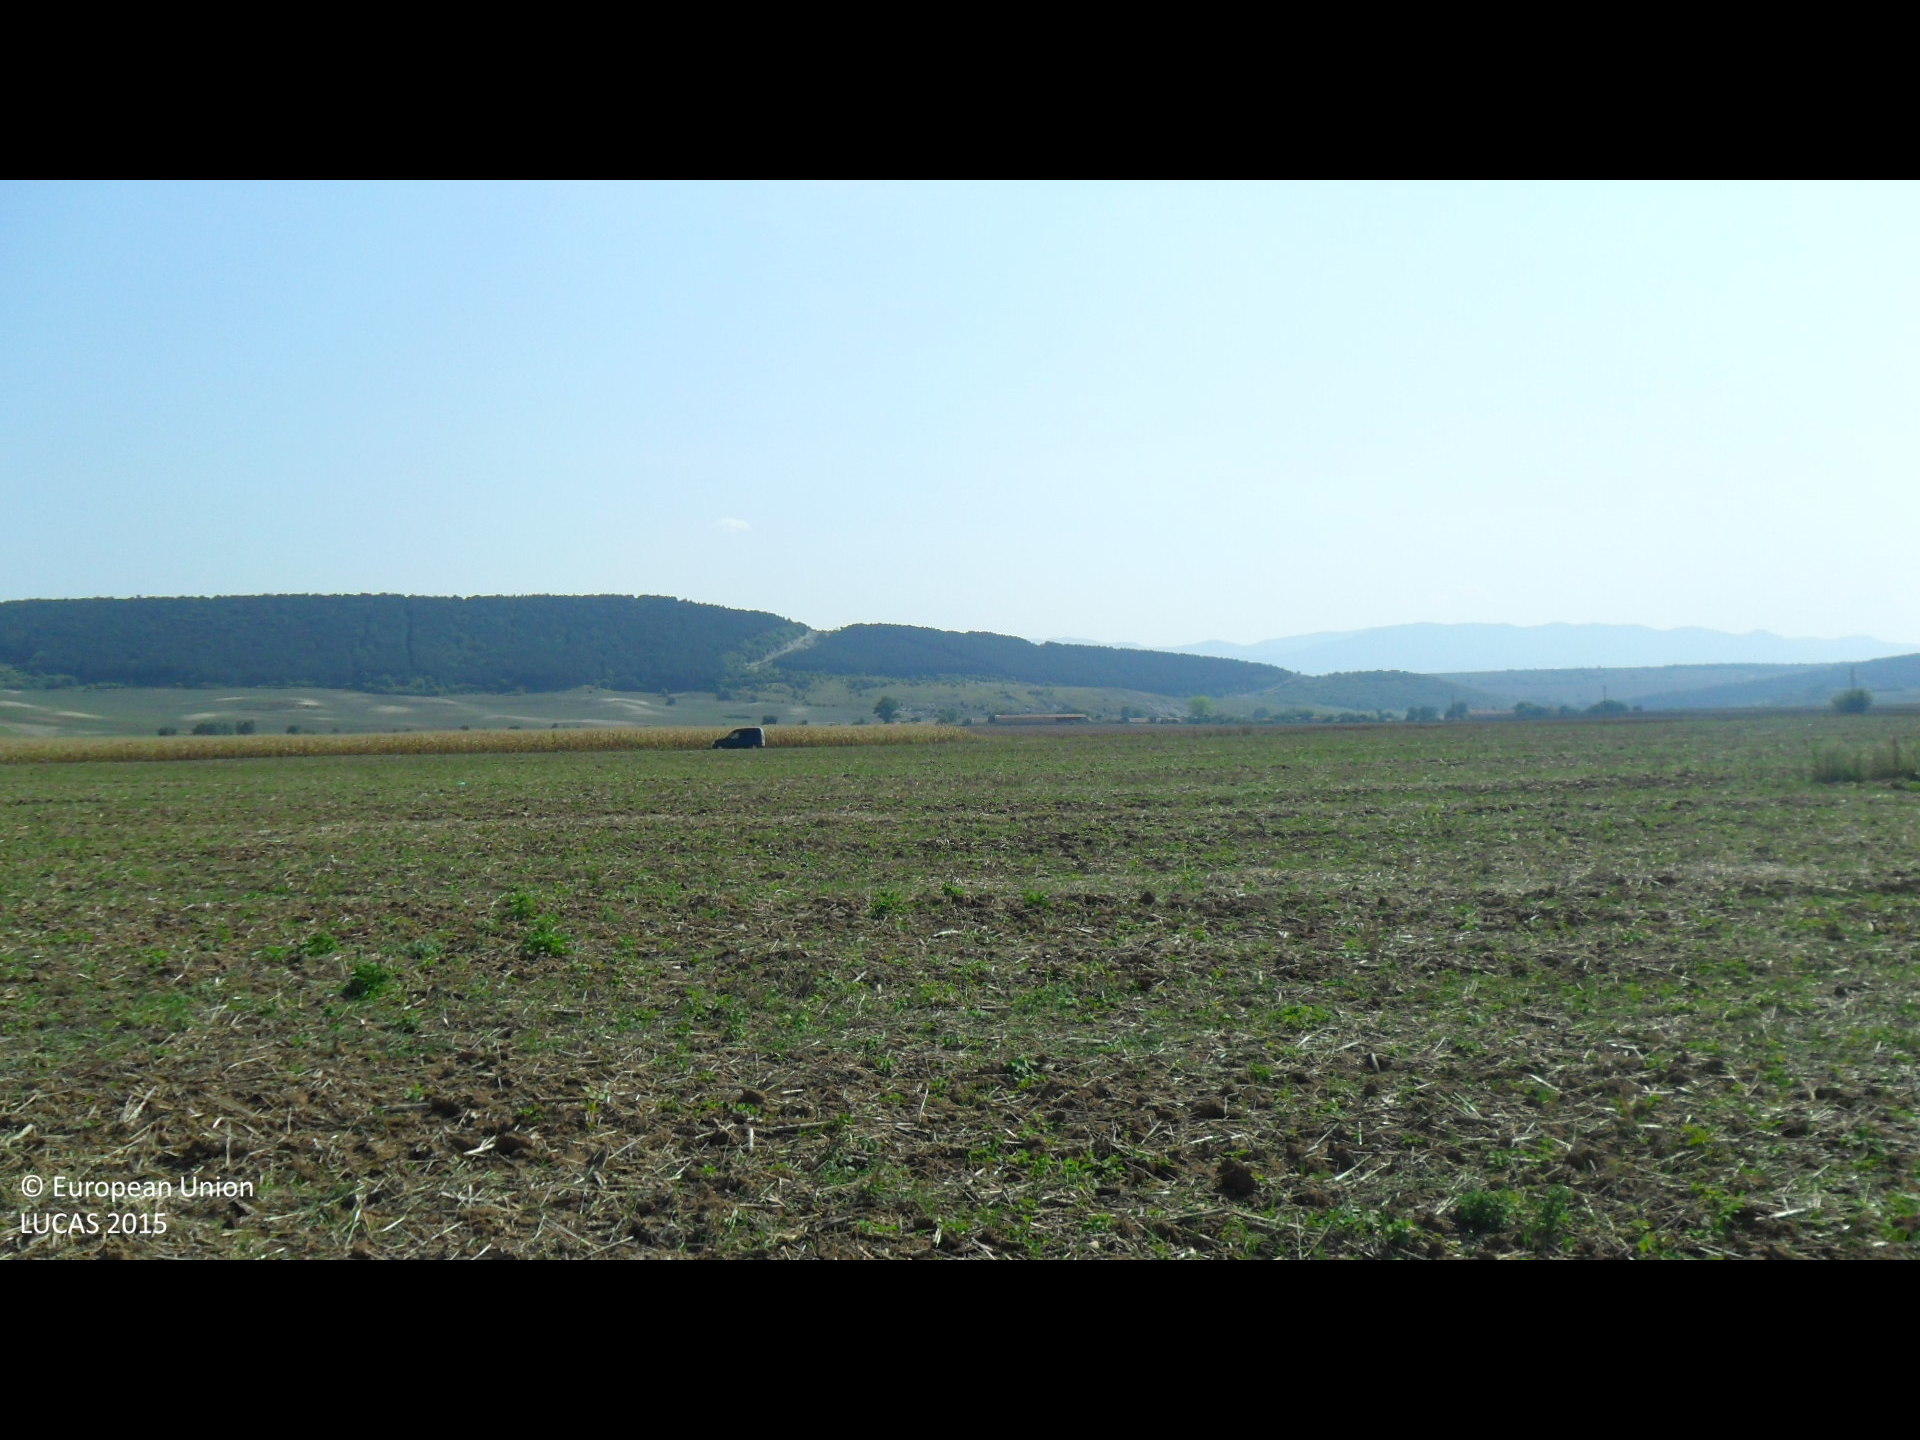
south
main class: Cropland
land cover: Common wheat
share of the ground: < 10 %
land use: Agriculture (excluding fallow land and kitchen gardens)
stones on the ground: < 10 %
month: September
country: BG
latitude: 43.0994
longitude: 26.6788
